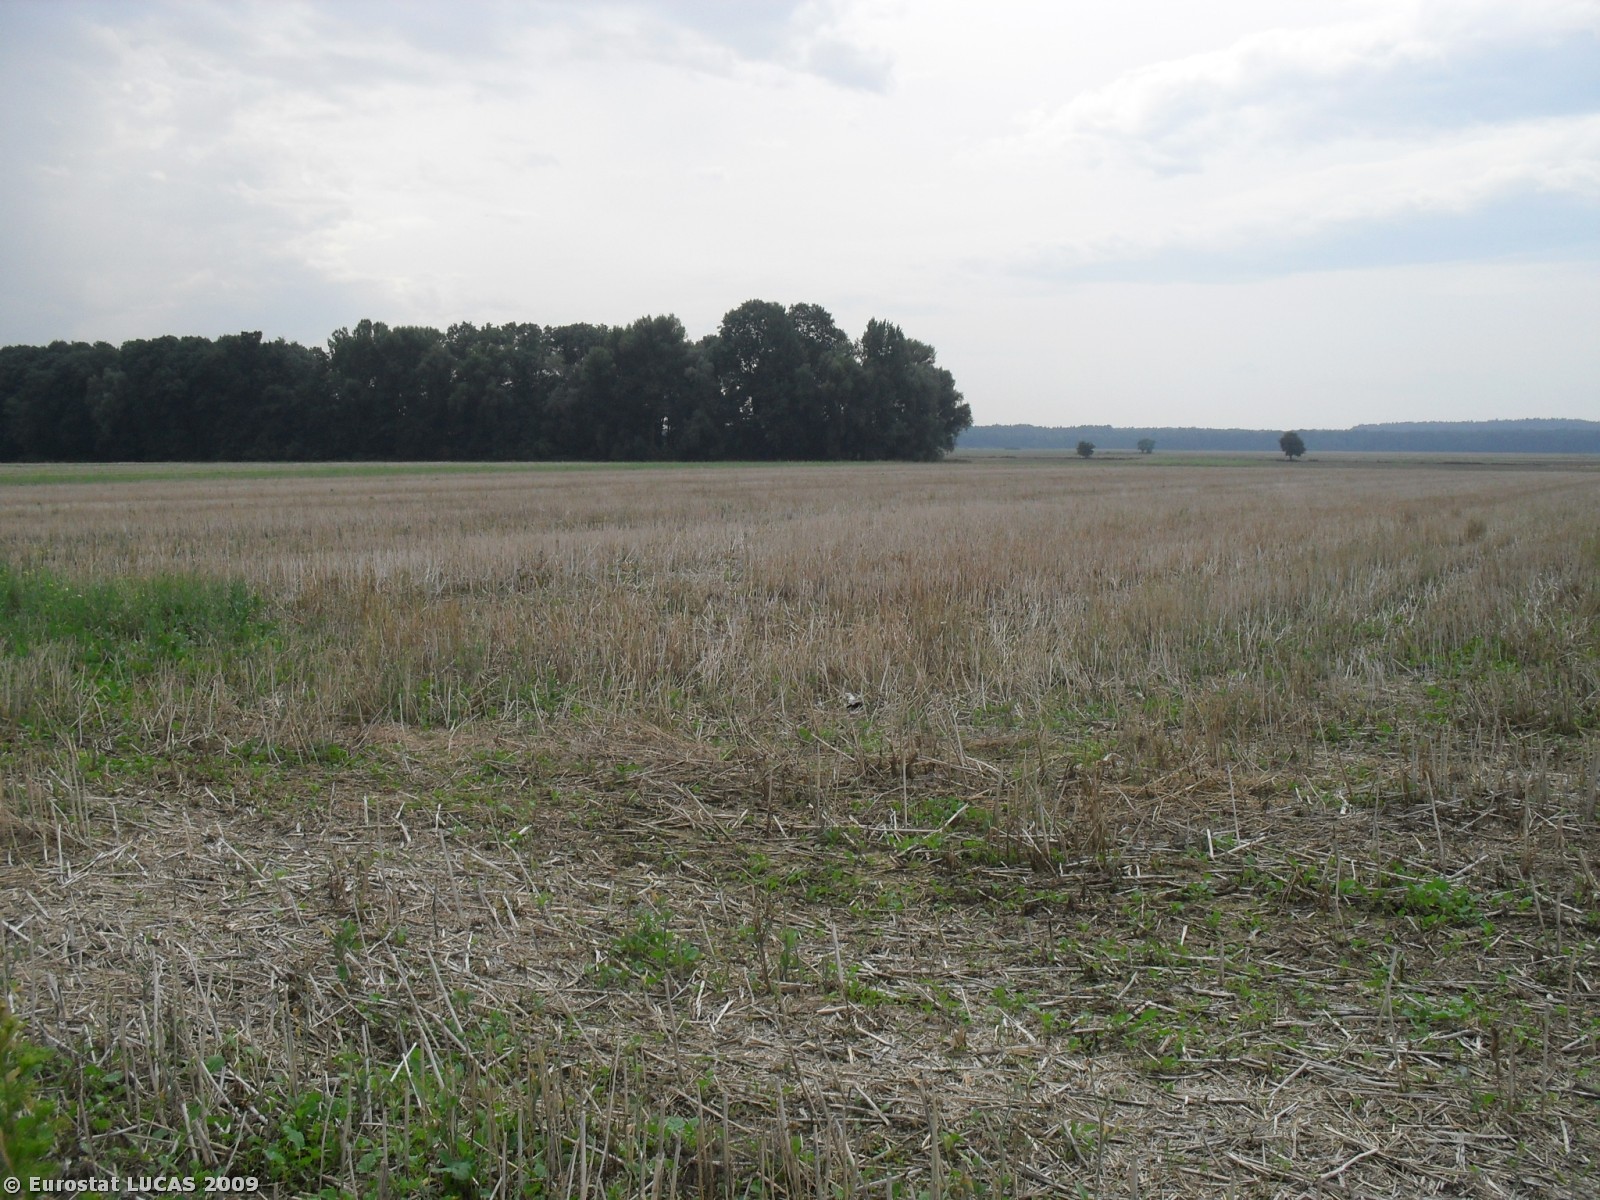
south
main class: Cropland
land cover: Rape and turnip rape
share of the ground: < 10 %
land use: Agriculture (excluding fallow land and kitchen gardens)
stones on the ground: < 10 %
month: September
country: PL
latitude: 50.7242
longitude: 17.3355
